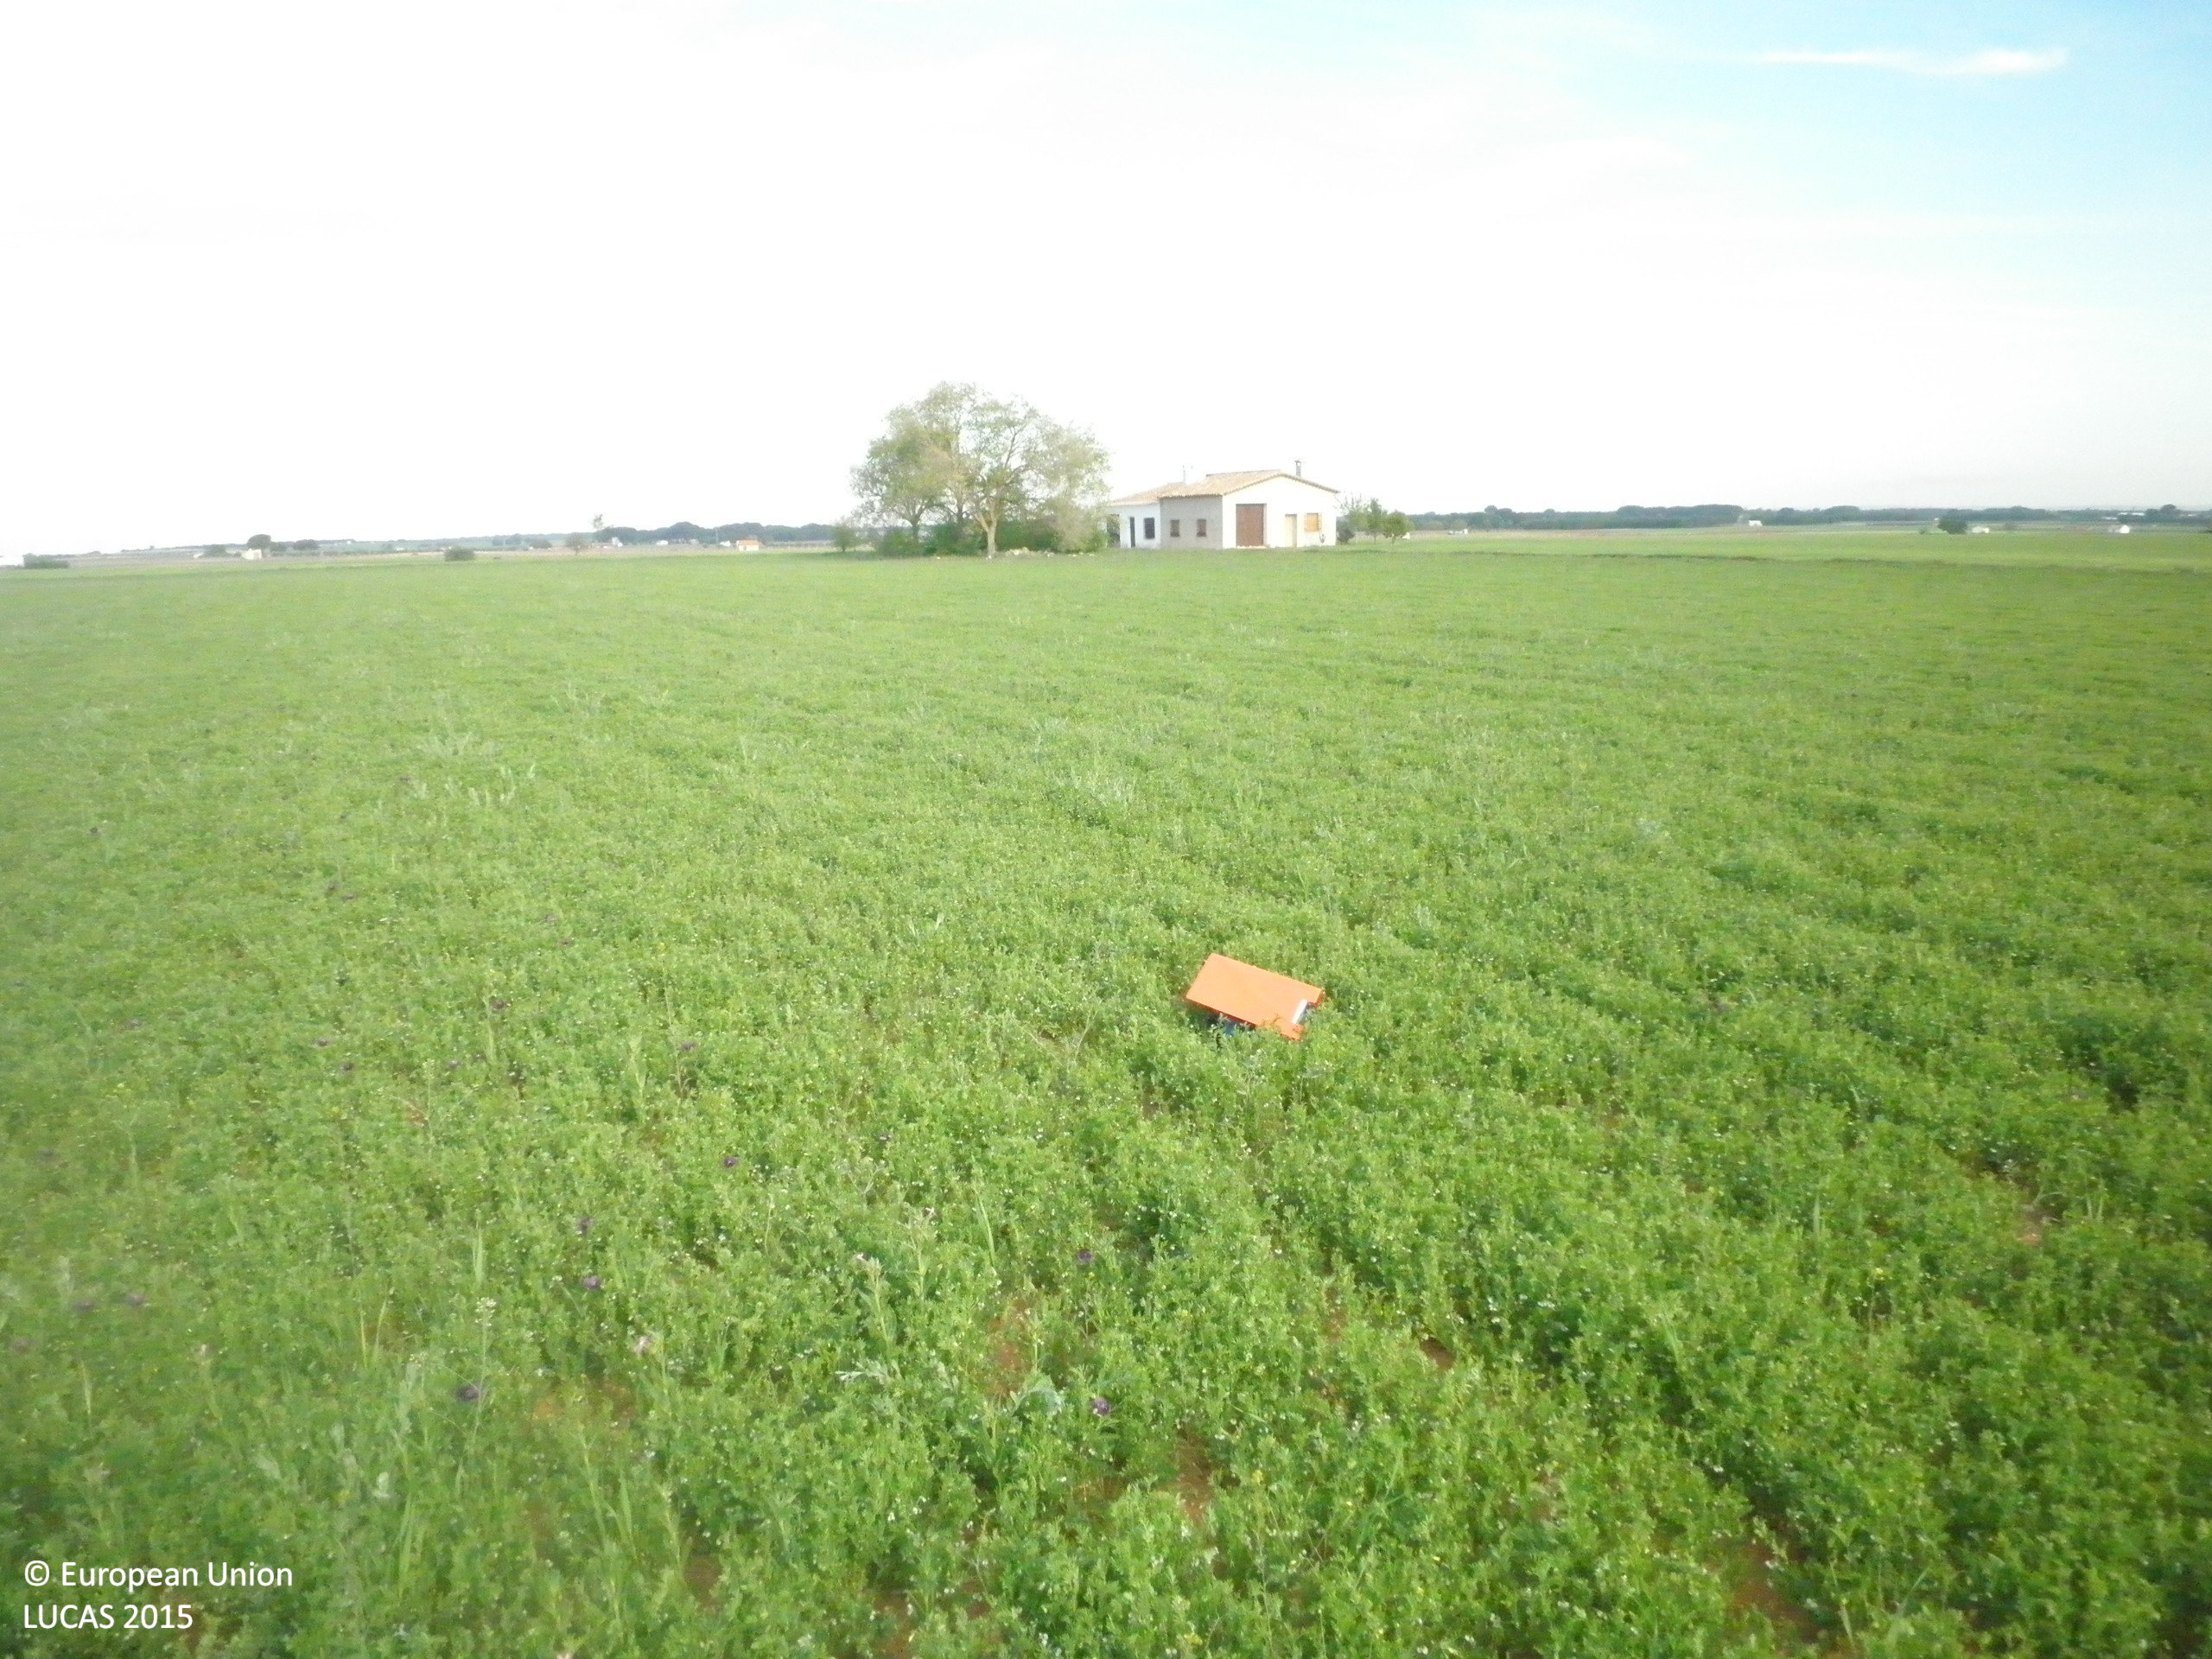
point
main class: Cropland
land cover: Dry pulses
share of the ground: > 75 %
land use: Agriculture (excluding fallow land and kitchen gardens)
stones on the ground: < 10 %
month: April
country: ES
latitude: 39.3447
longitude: -2.5771
